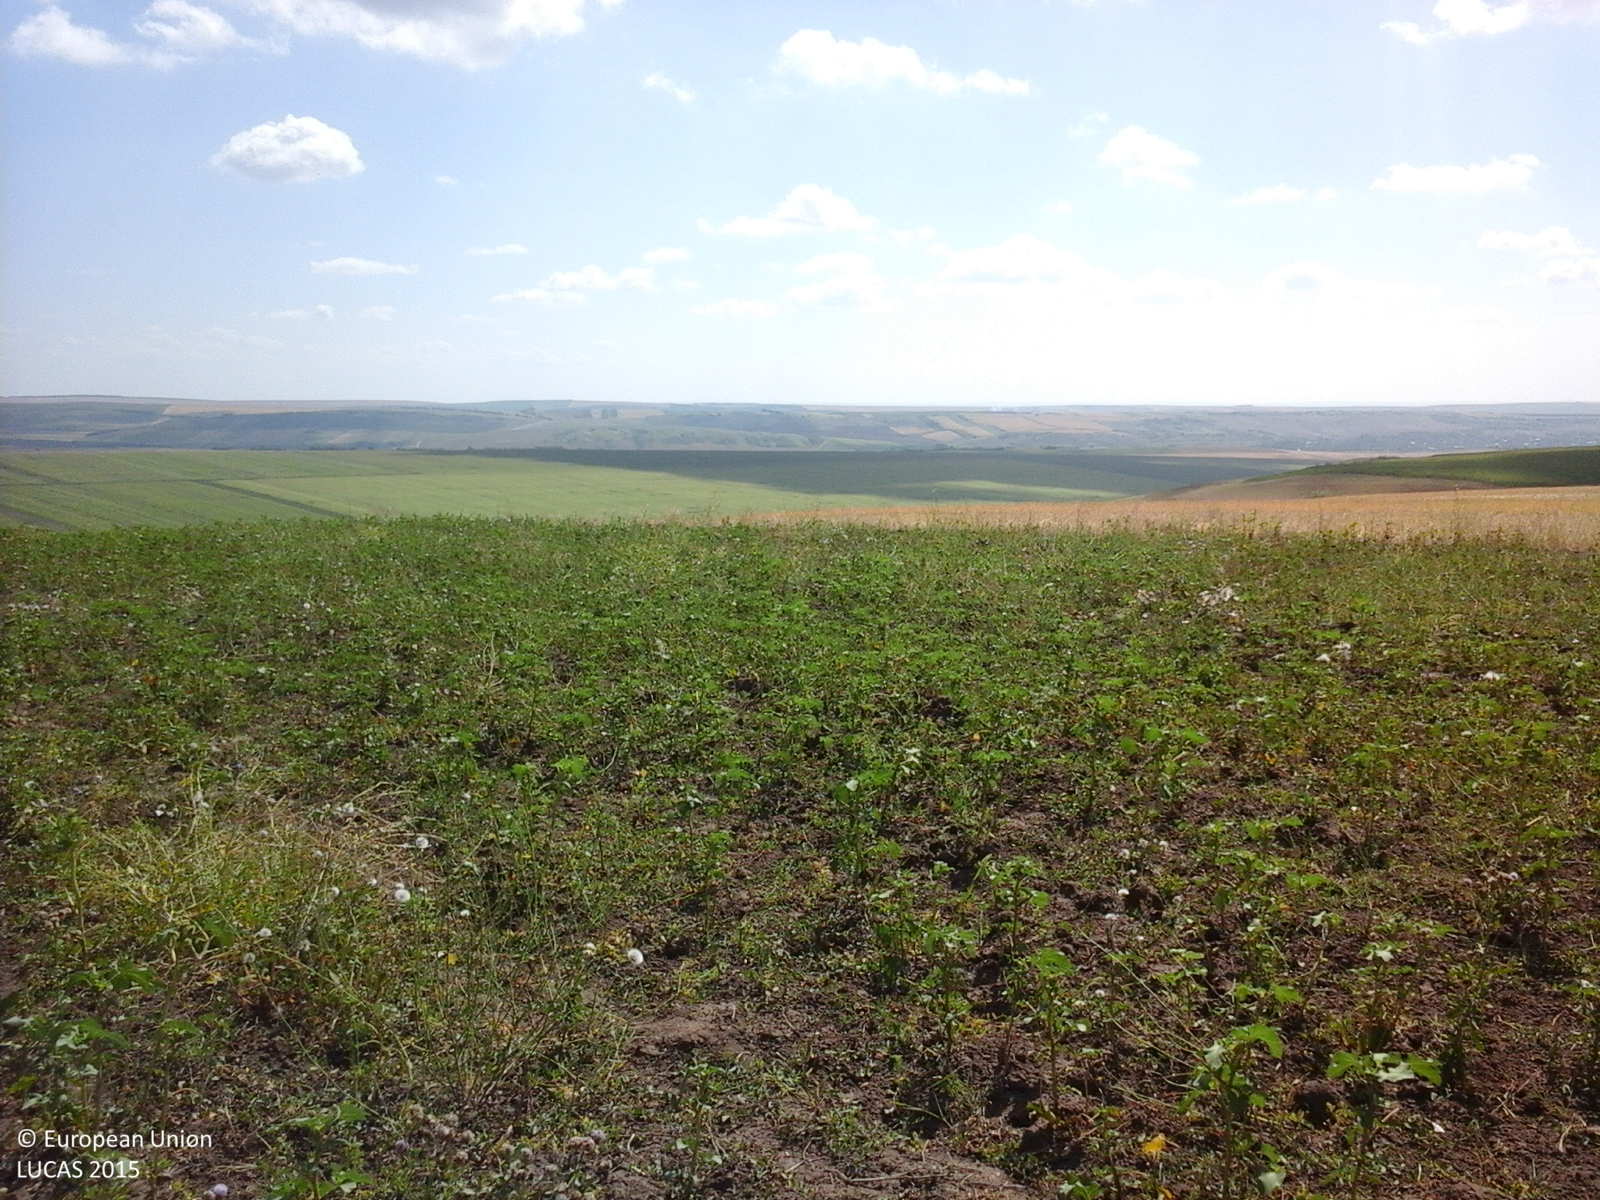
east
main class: Grassland
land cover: Spontaneously vegetated surfaces
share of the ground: > 75 %
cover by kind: herbaceous plants 100 %
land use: Fallow land
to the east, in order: Spontaneously vegetated surfaces; Grassland without tree/shrub cover; Tracks; Grassland without tree/shrub cover
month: July
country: RO
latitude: 46.3312
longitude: 27.9323
